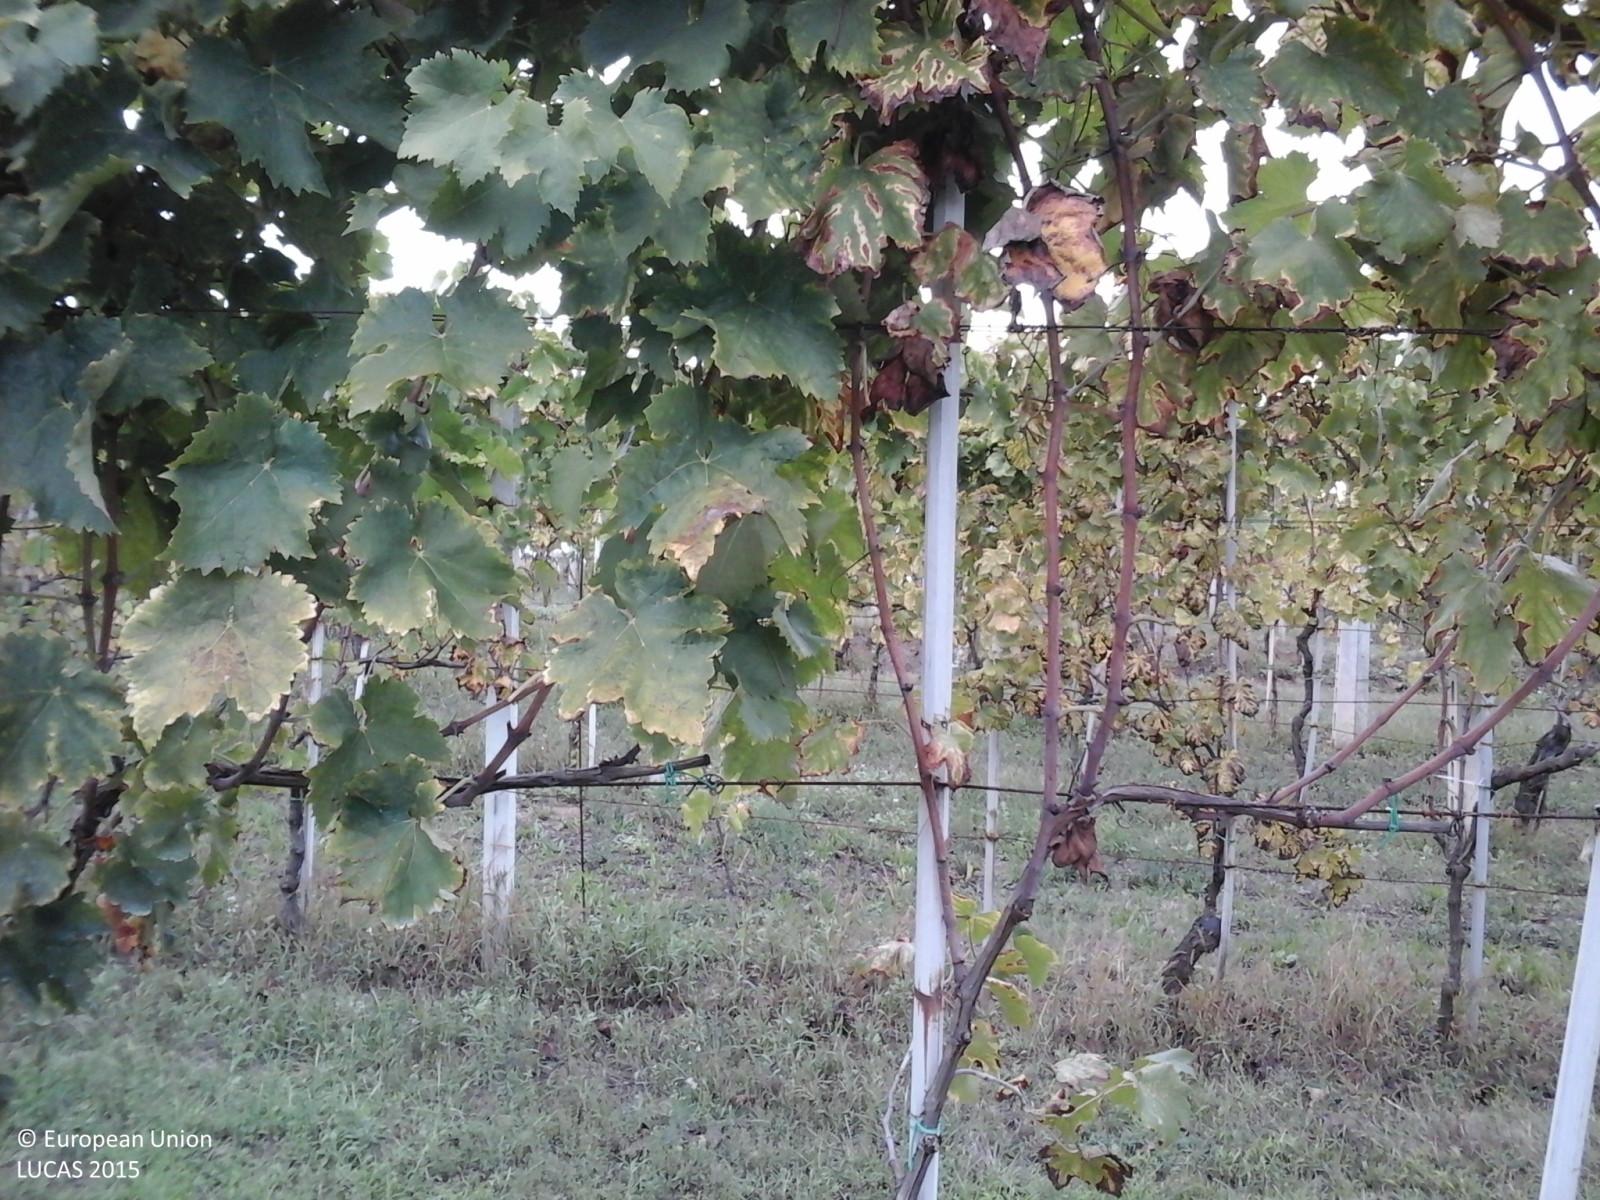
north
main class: Cropland
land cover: Vineyards
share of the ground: 50 - 75 %
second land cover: Grassland without tree/shrub cover
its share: > 75 %
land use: Agriculture (excluding fallow land and kitchen gardens)
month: October
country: IT
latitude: 43.5153
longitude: 13.4924
